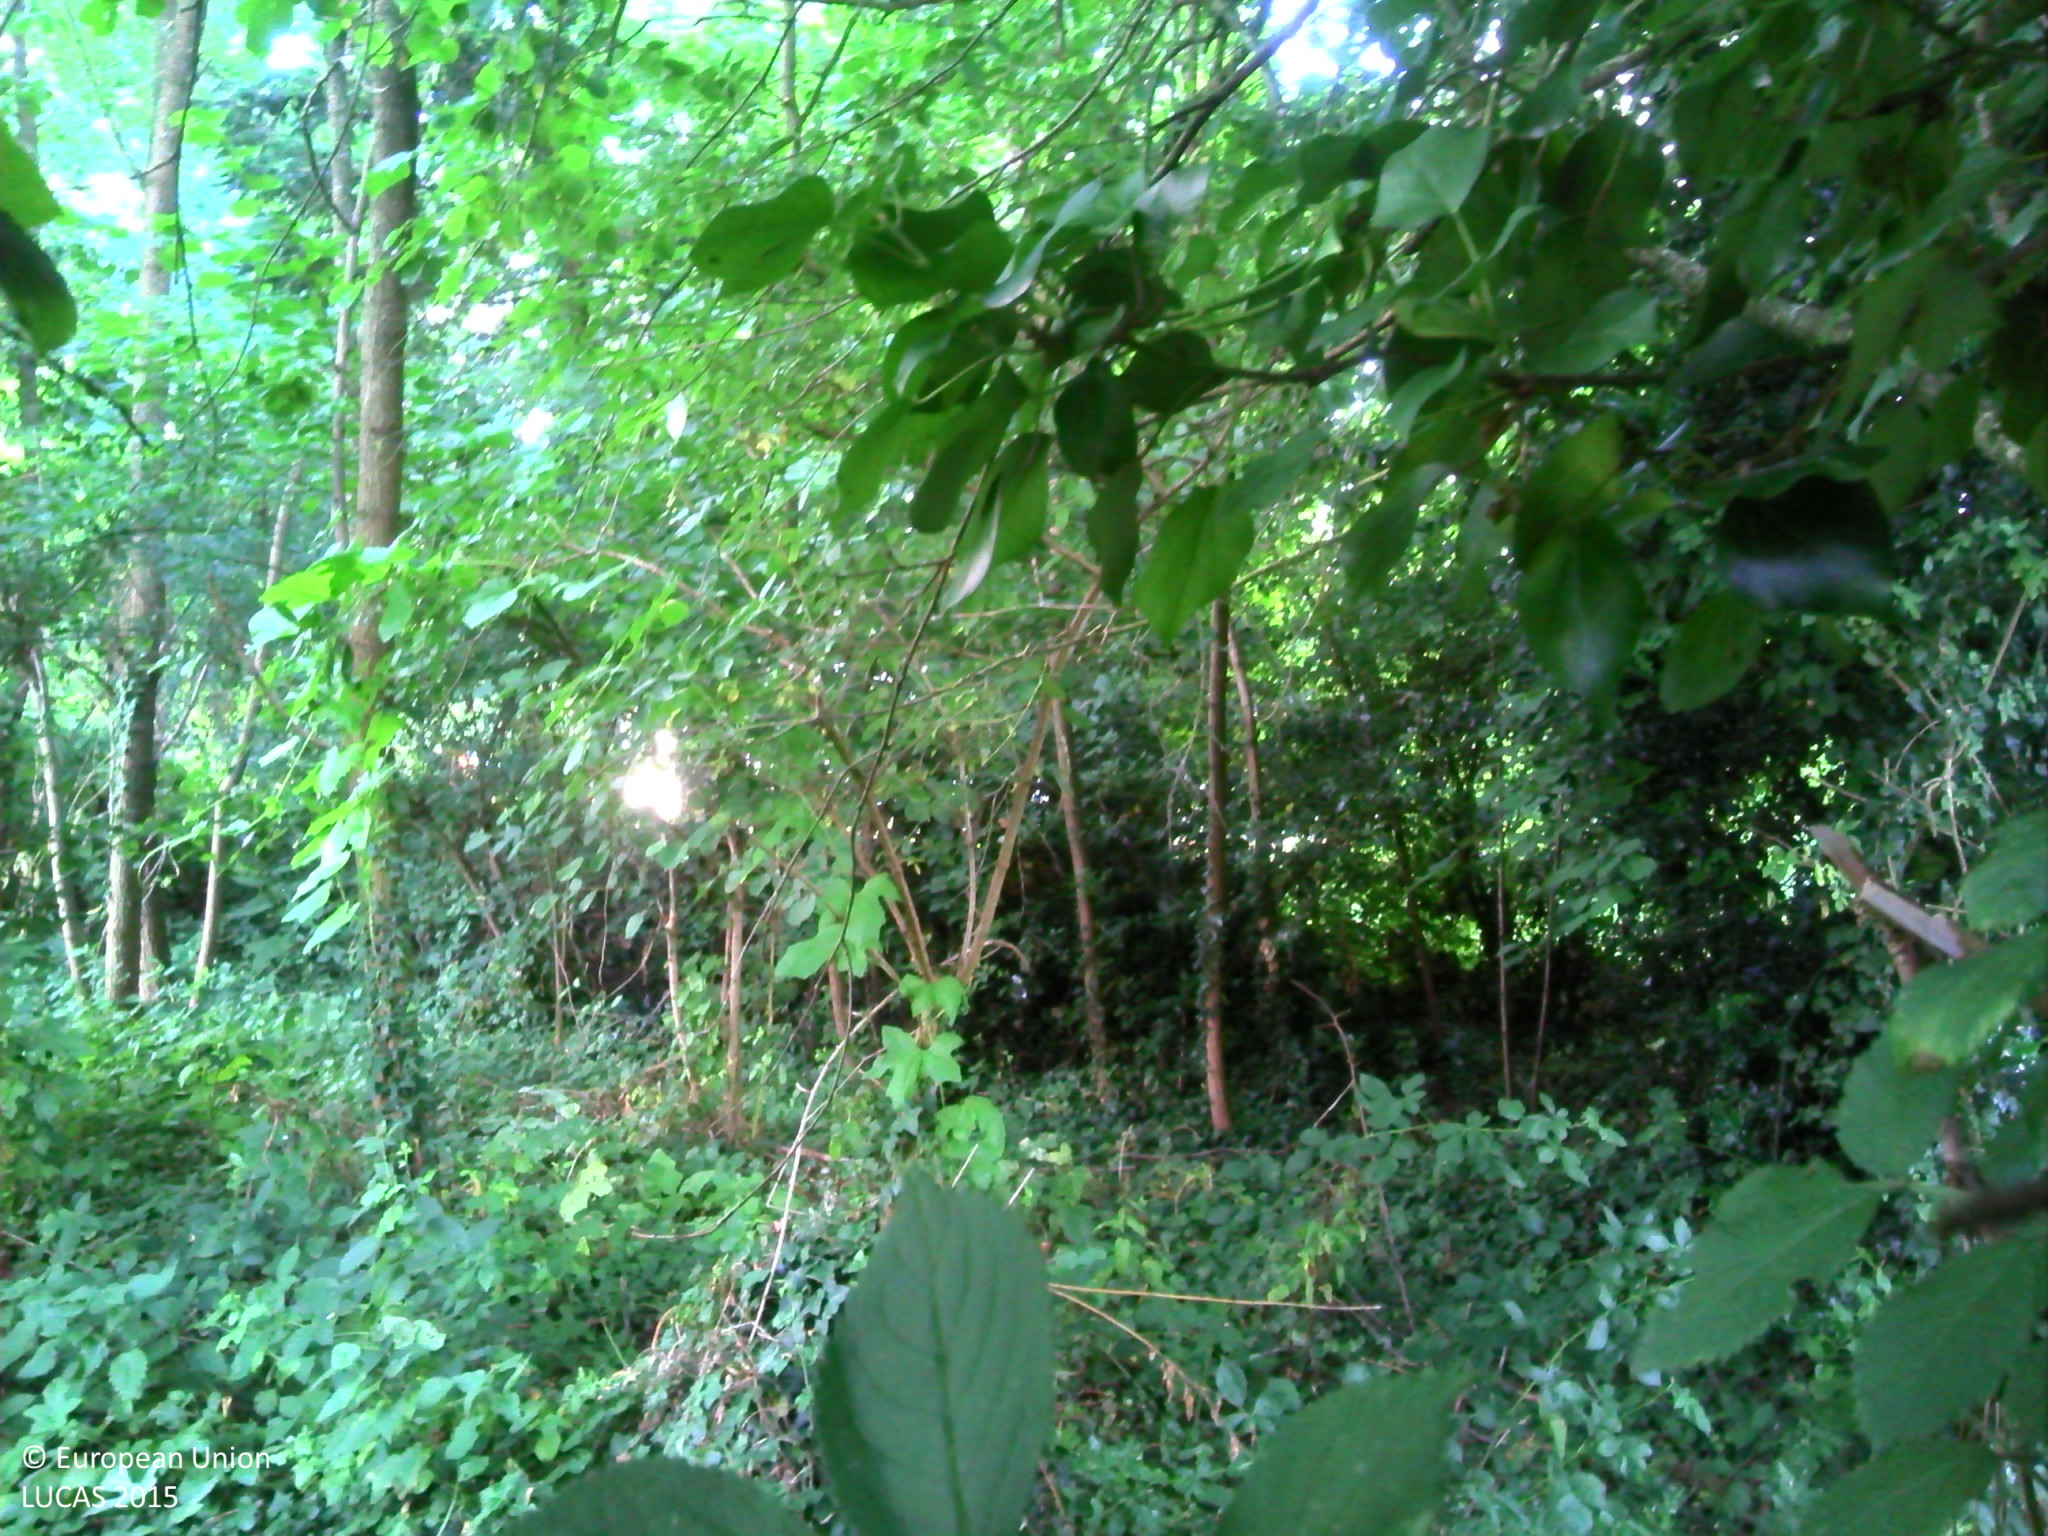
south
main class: Woodland
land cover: Broadleaved woodland
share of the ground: > 75 %
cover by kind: broadleaved forest trees 90 %, herbaceous plants 10 %
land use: Residential
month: July
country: FR
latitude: 47.5180
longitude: -1.9341
